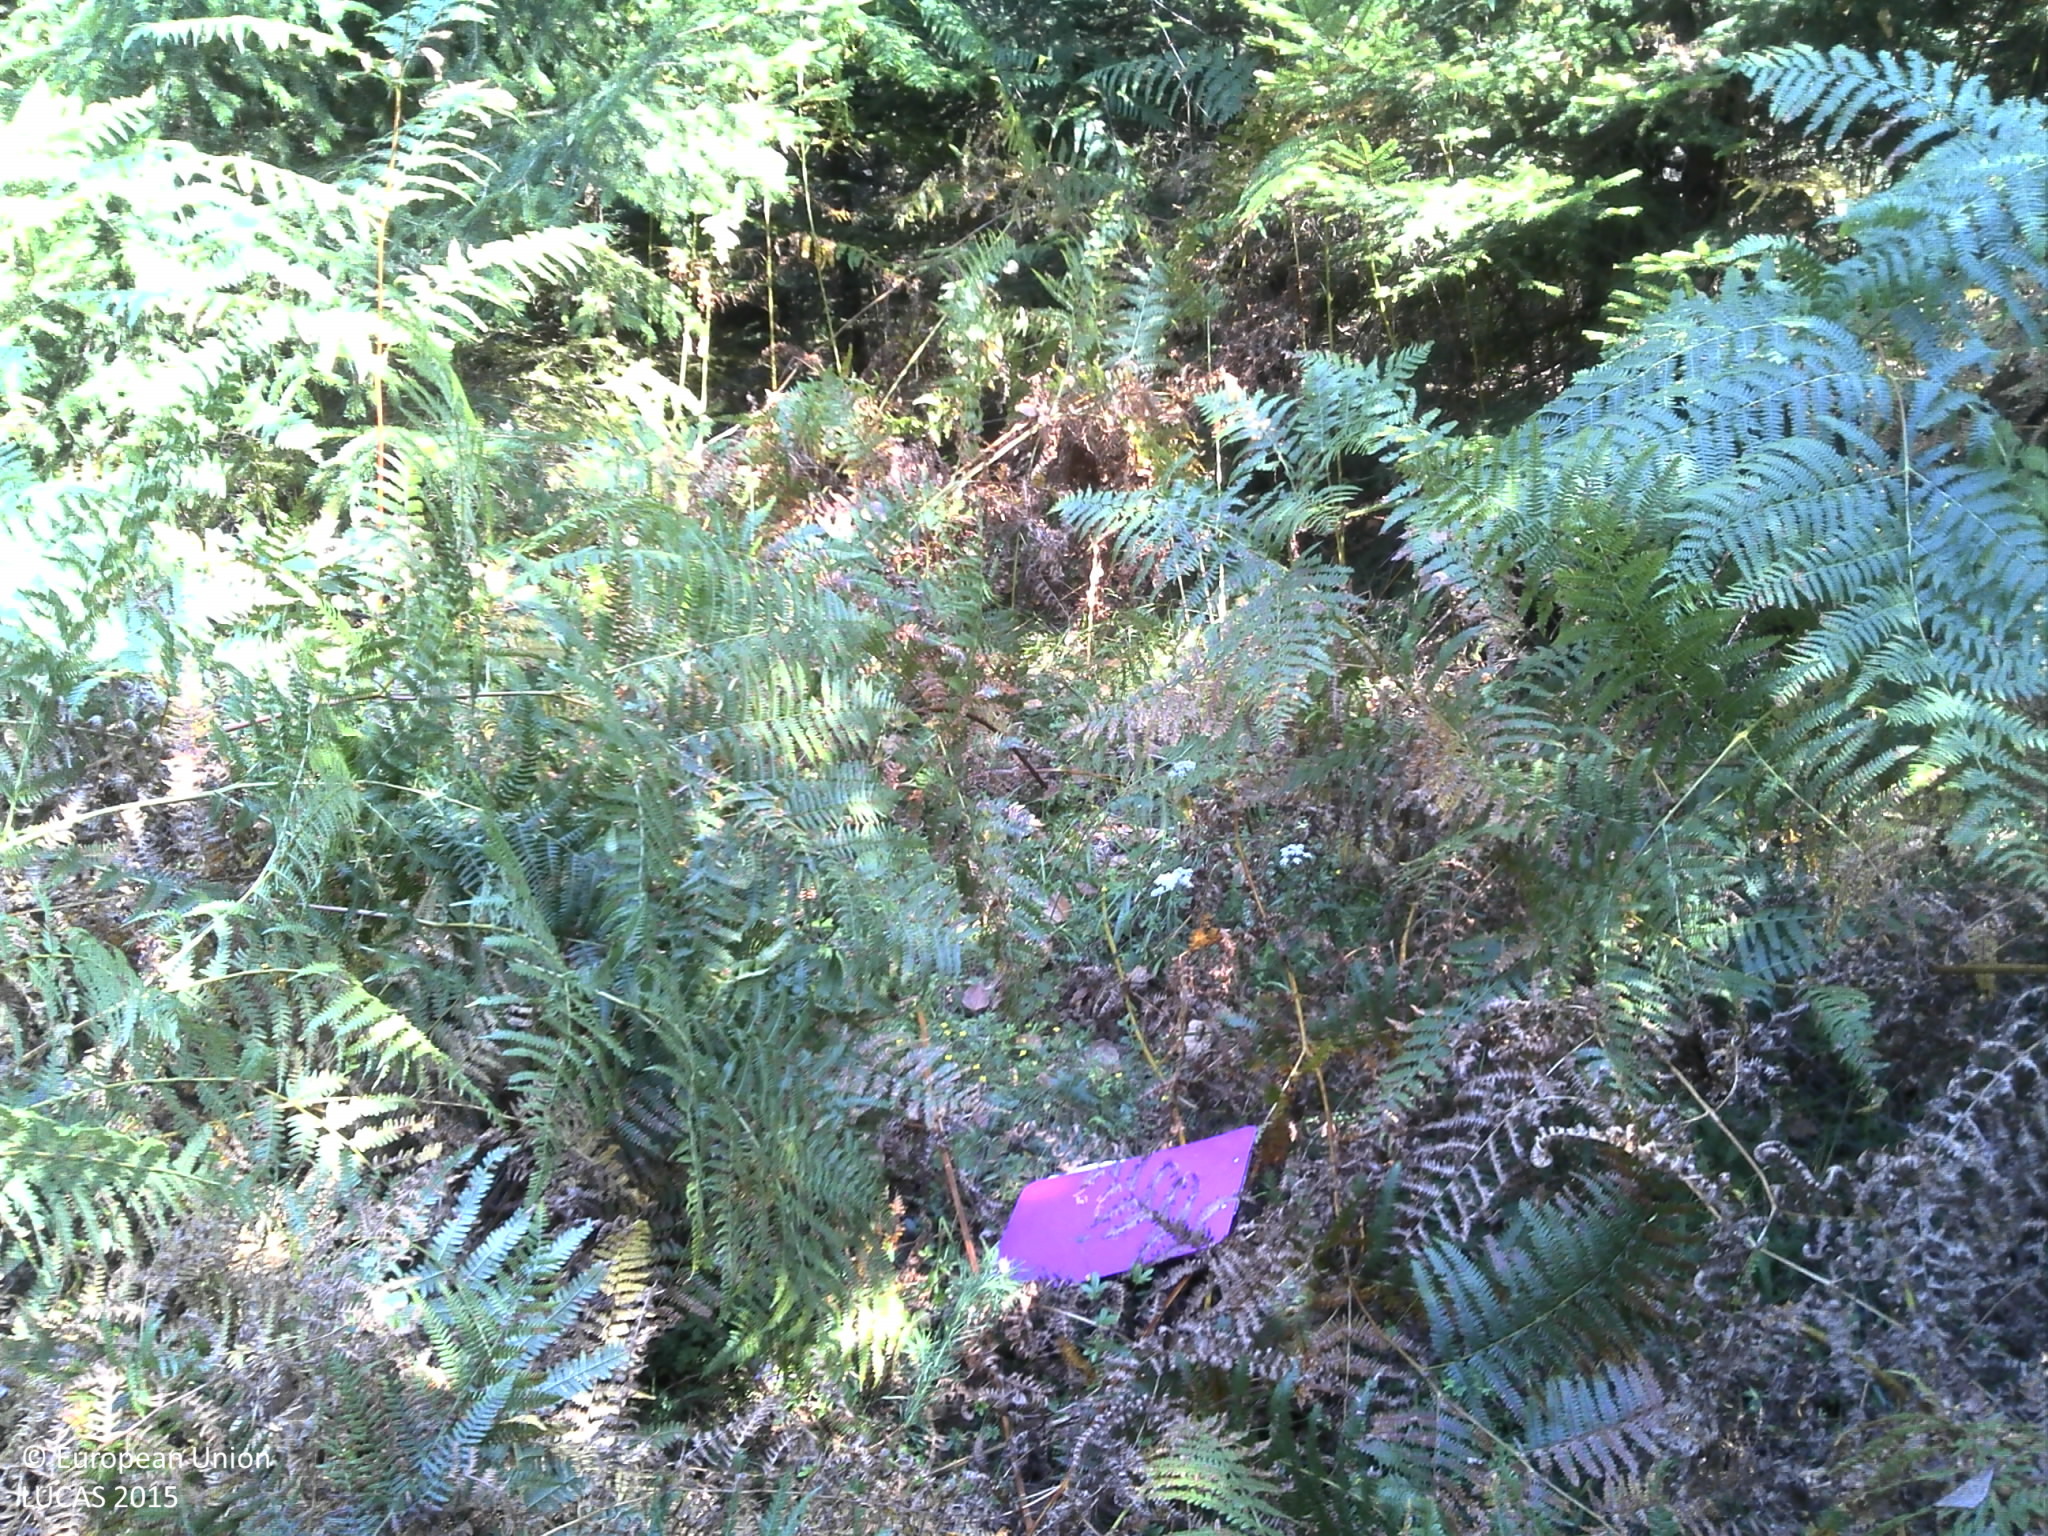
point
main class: Woodland
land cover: Spruce dominated coniferous woodland
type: coniferous forest of the mediterranean region
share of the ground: > 75 %
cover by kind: coniferous forest trees 100 %
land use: Forestry
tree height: > 5 m
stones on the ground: < 10 %
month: September
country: HR
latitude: 45.3177
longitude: 15.2894
